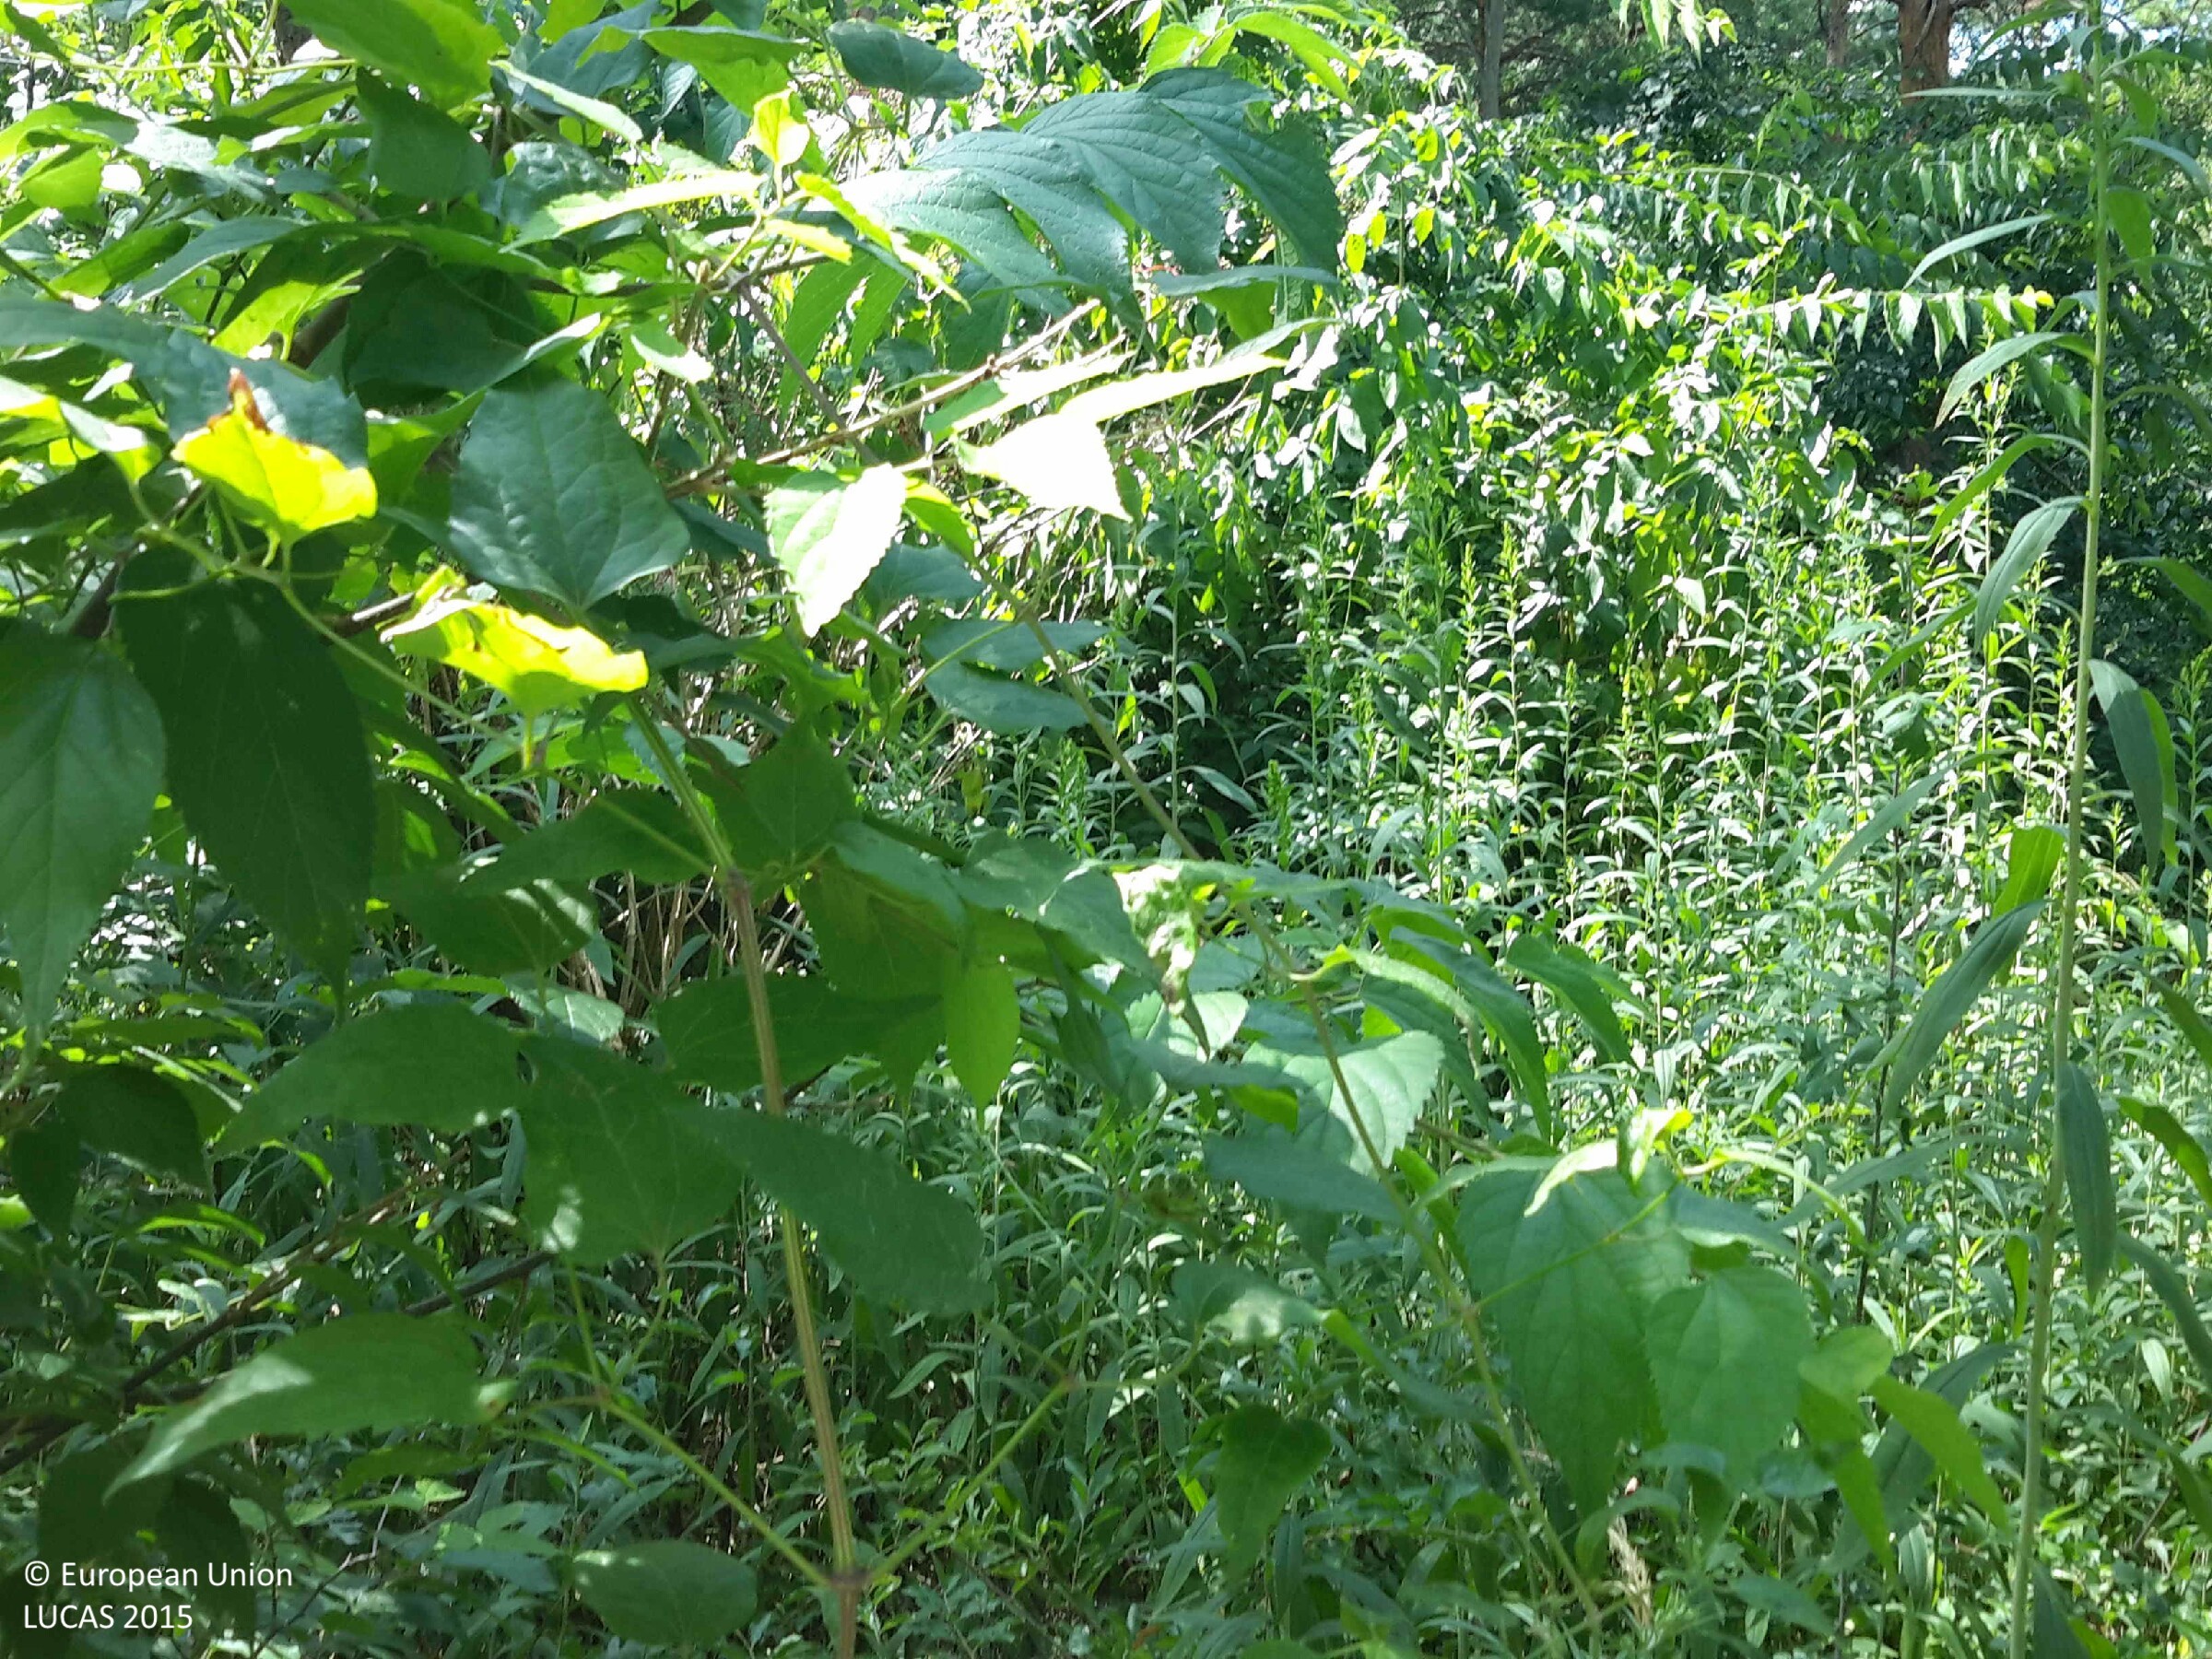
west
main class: Woodland
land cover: Broadleaved woodland
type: mesophytic deciduous forest
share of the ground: 50 - 75 %
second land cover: Spontaneously vegetated surfaces
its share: 25 - 50 %
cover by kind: broadleaved forest trees 70 %, shrubs 20 %, herbaceous plants 10 %
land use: Forestry
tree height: > 5 m
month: July
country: HU
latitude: 47.7235
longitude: 17.8899
